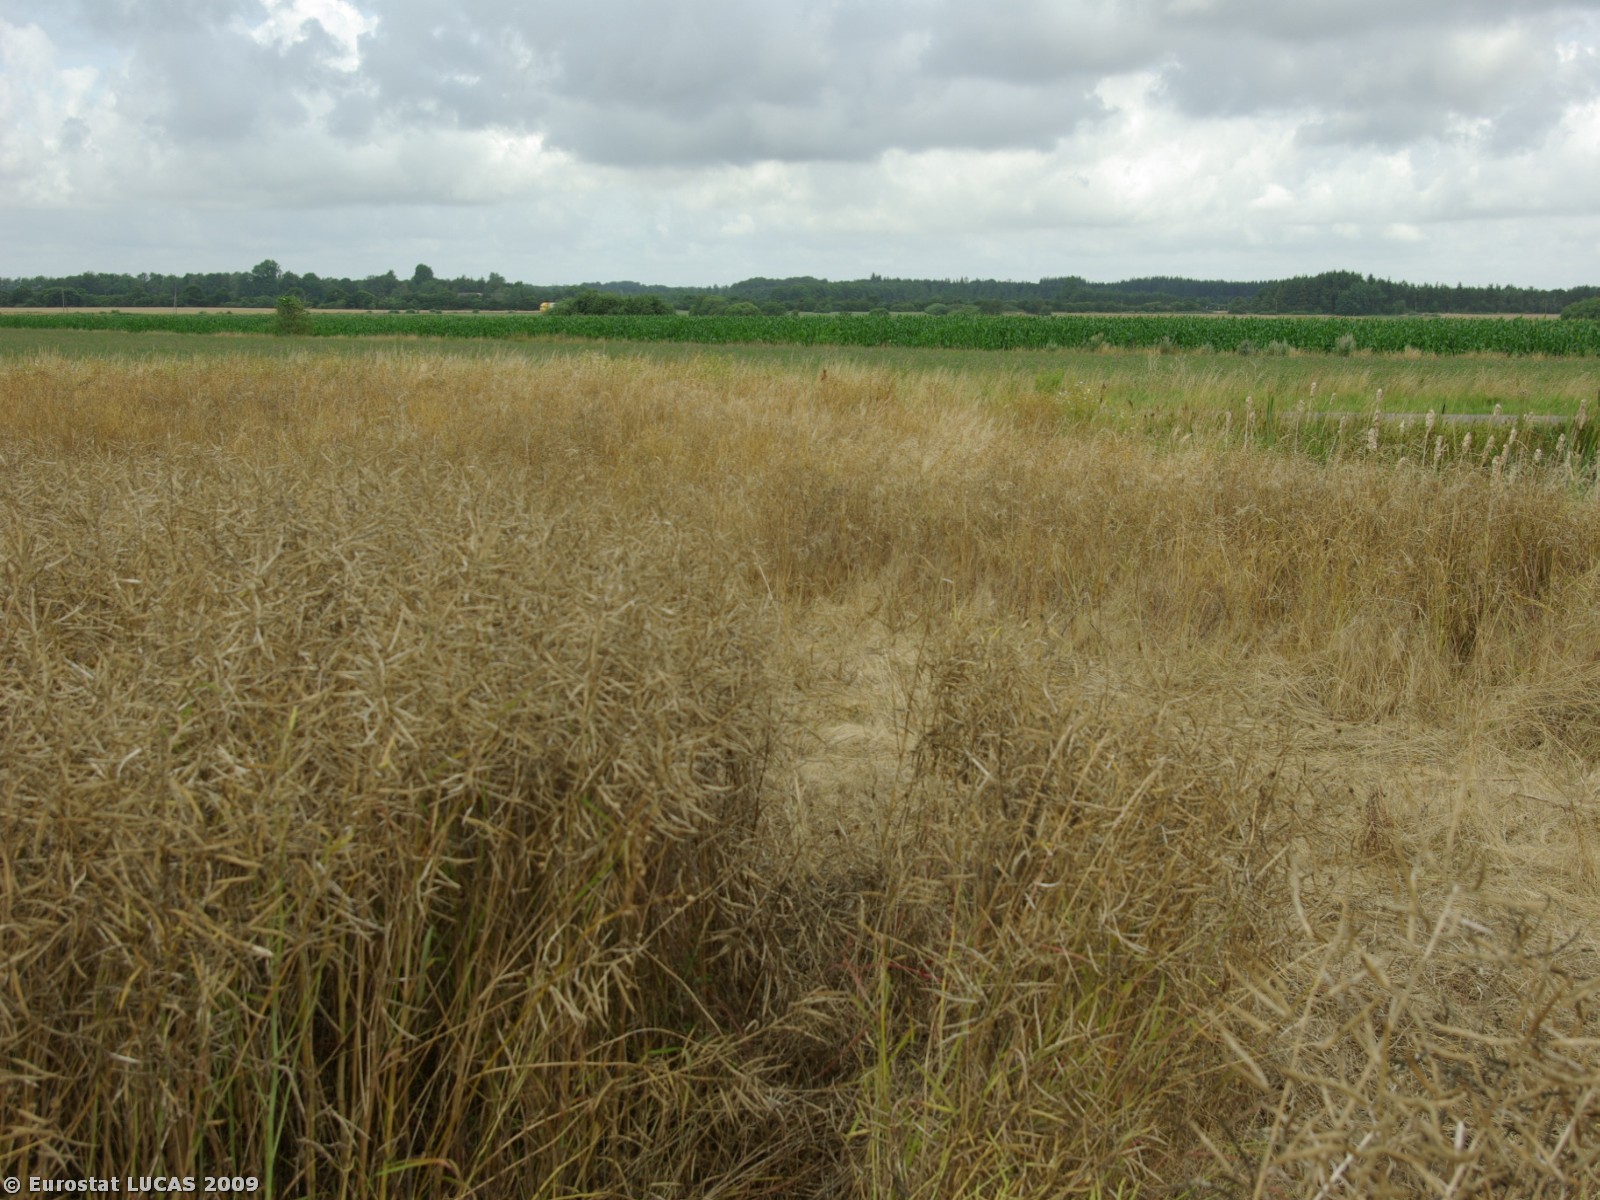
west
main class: Cropland
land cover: Rape and turnip rape
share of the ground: > 75 %
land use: Agriculture (excluding fallow land and kitchen gardens)
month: July
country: DK
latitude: 54.9606
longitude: 8.8920
